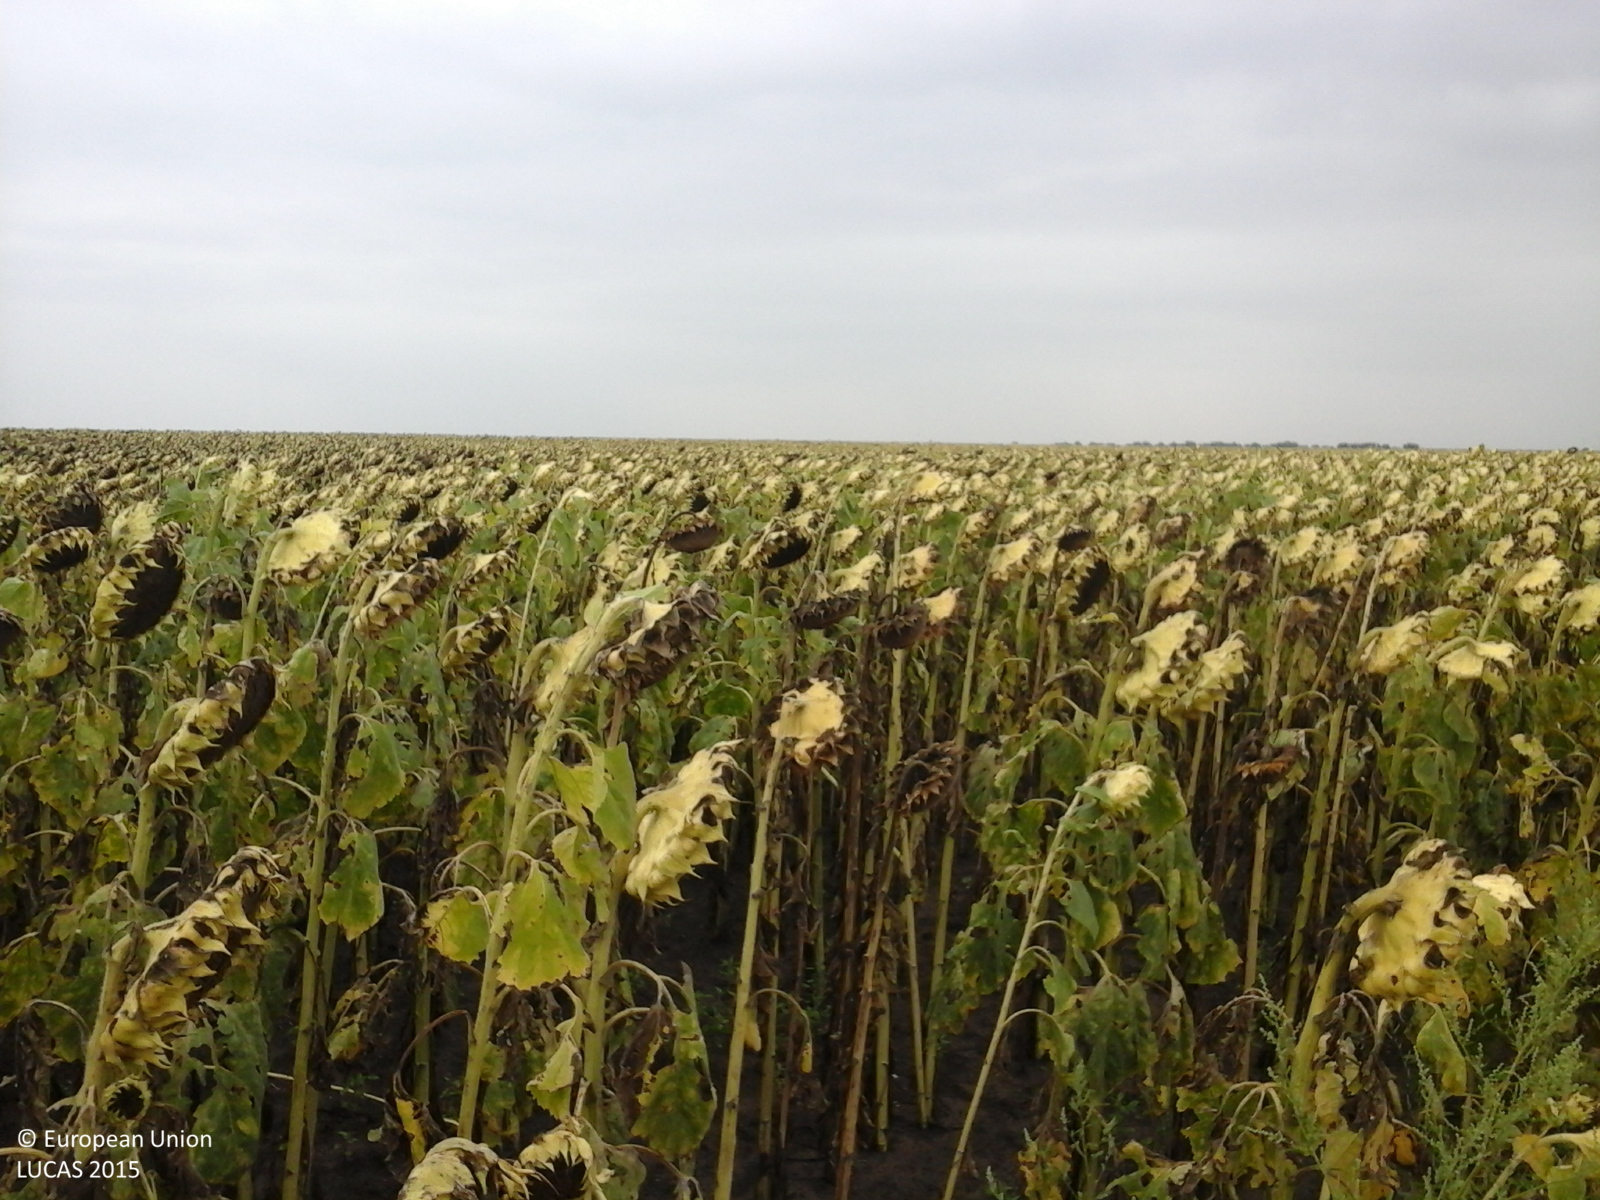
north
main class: Cropland
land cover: Sunflower
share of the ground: > 75 %
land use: Agriculture (excluding fallow land and kitchen gardens)
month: August
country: RO
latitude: 45.6344
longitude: 21.0214
